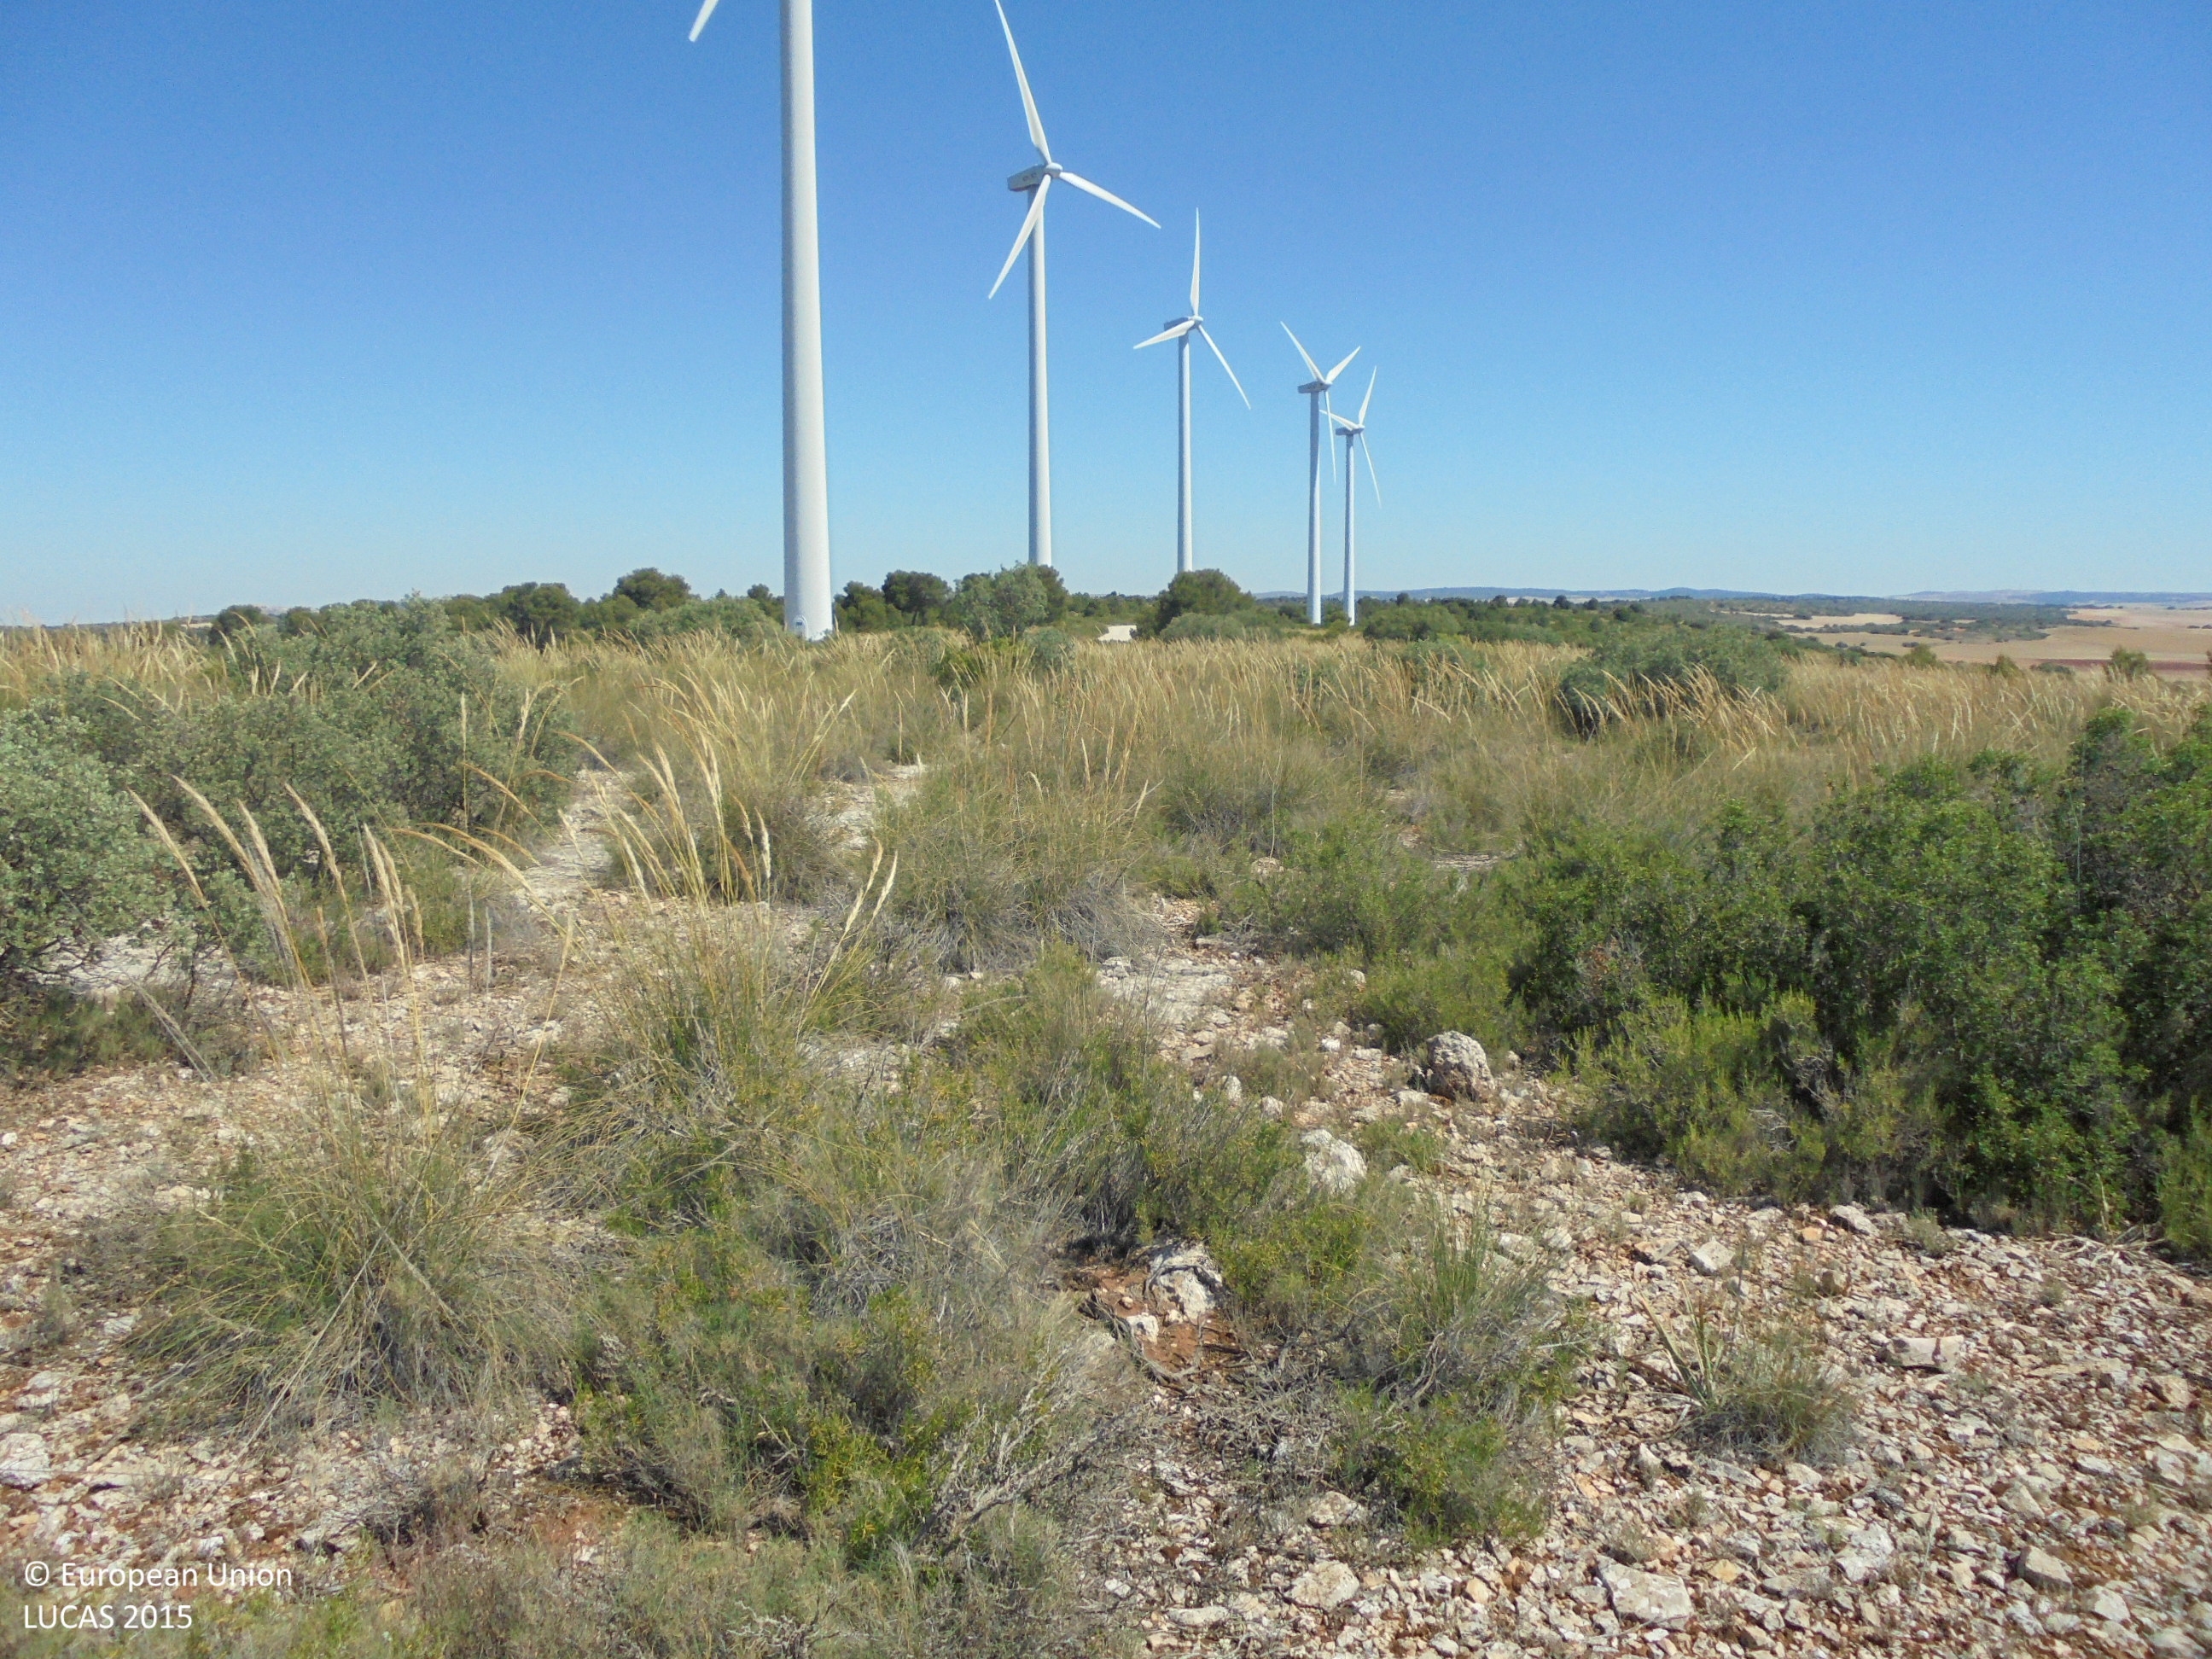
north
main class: Shrubland
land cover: Shrubland without tree cover
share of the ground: 50 - 75 %
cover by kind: shrubs 65 %, unconsolidated bare surface 25 %, consolidated bare surface 10 %
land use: Semi-natural and natural areas not in use
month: June
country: ES
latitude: 38.8378
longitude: -1.6674
